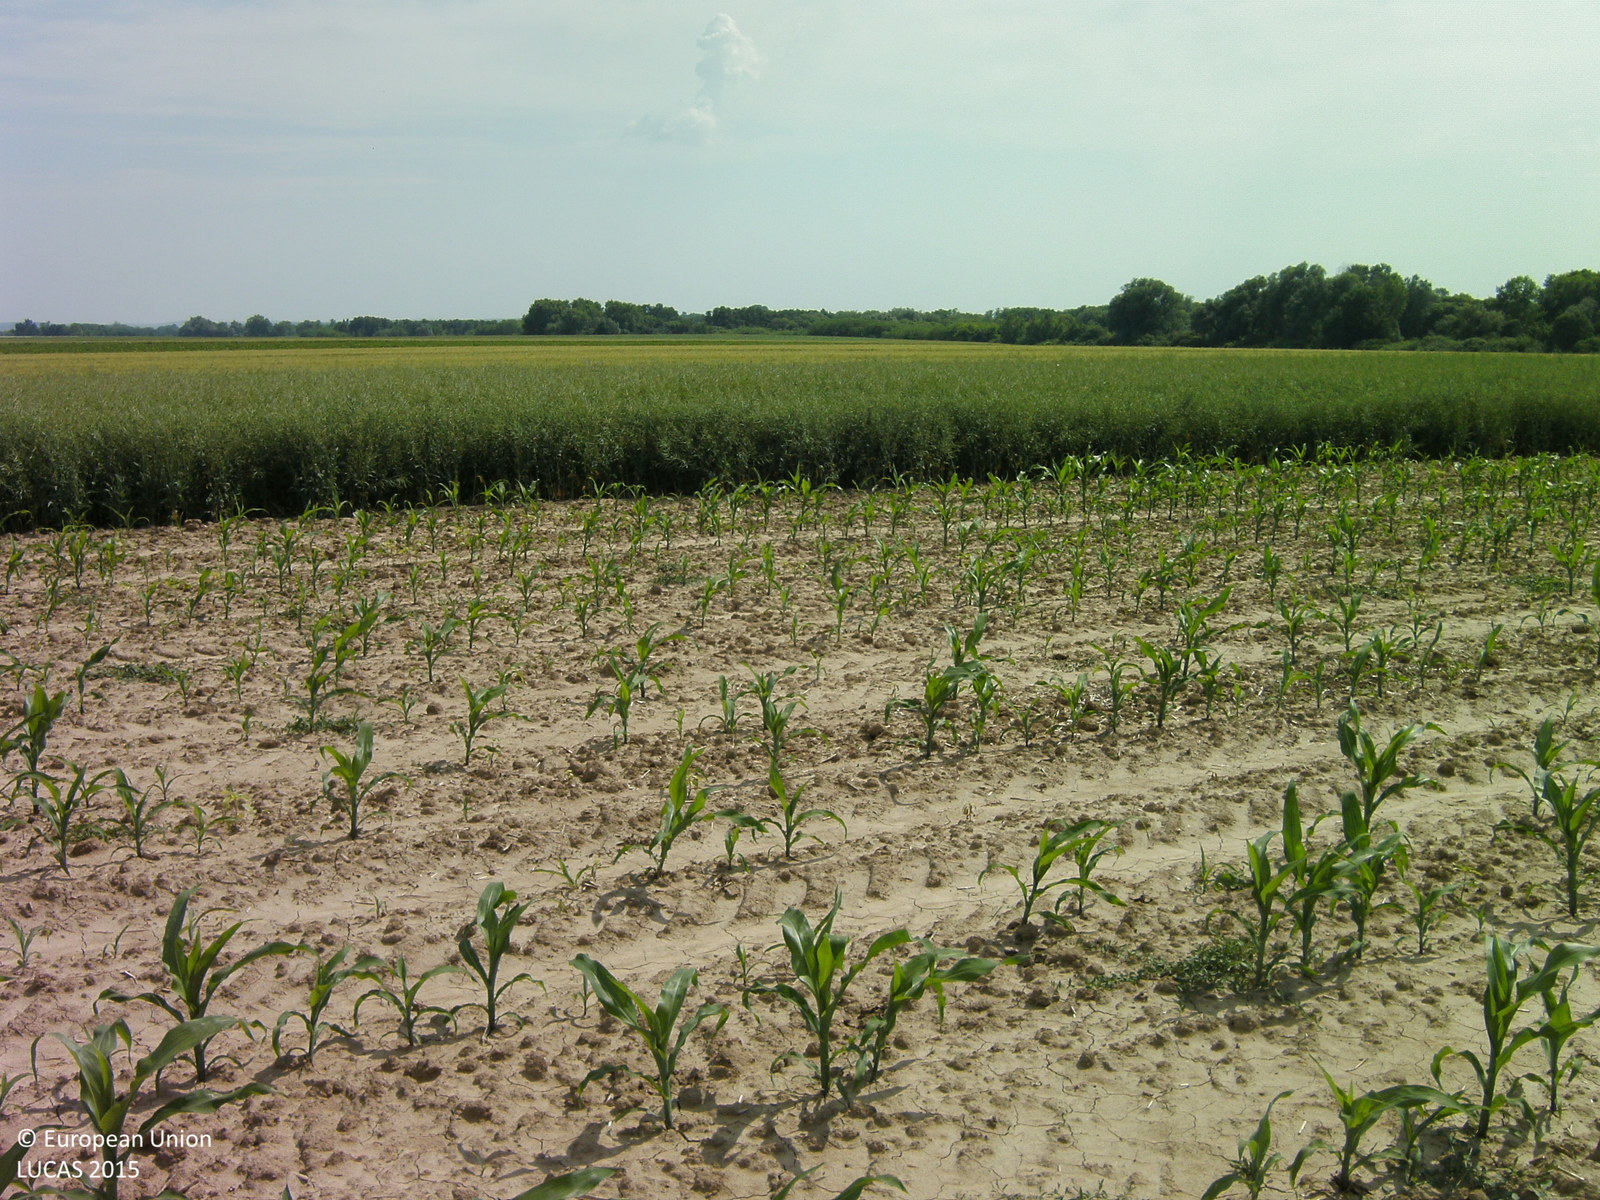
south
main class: Cropland
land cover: Maize
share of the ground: 10 - 25 %
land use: Agriculture (excluding fallow land and kitchen gardens)
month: June
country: HU
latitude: 46.4316
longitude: 17.7492
